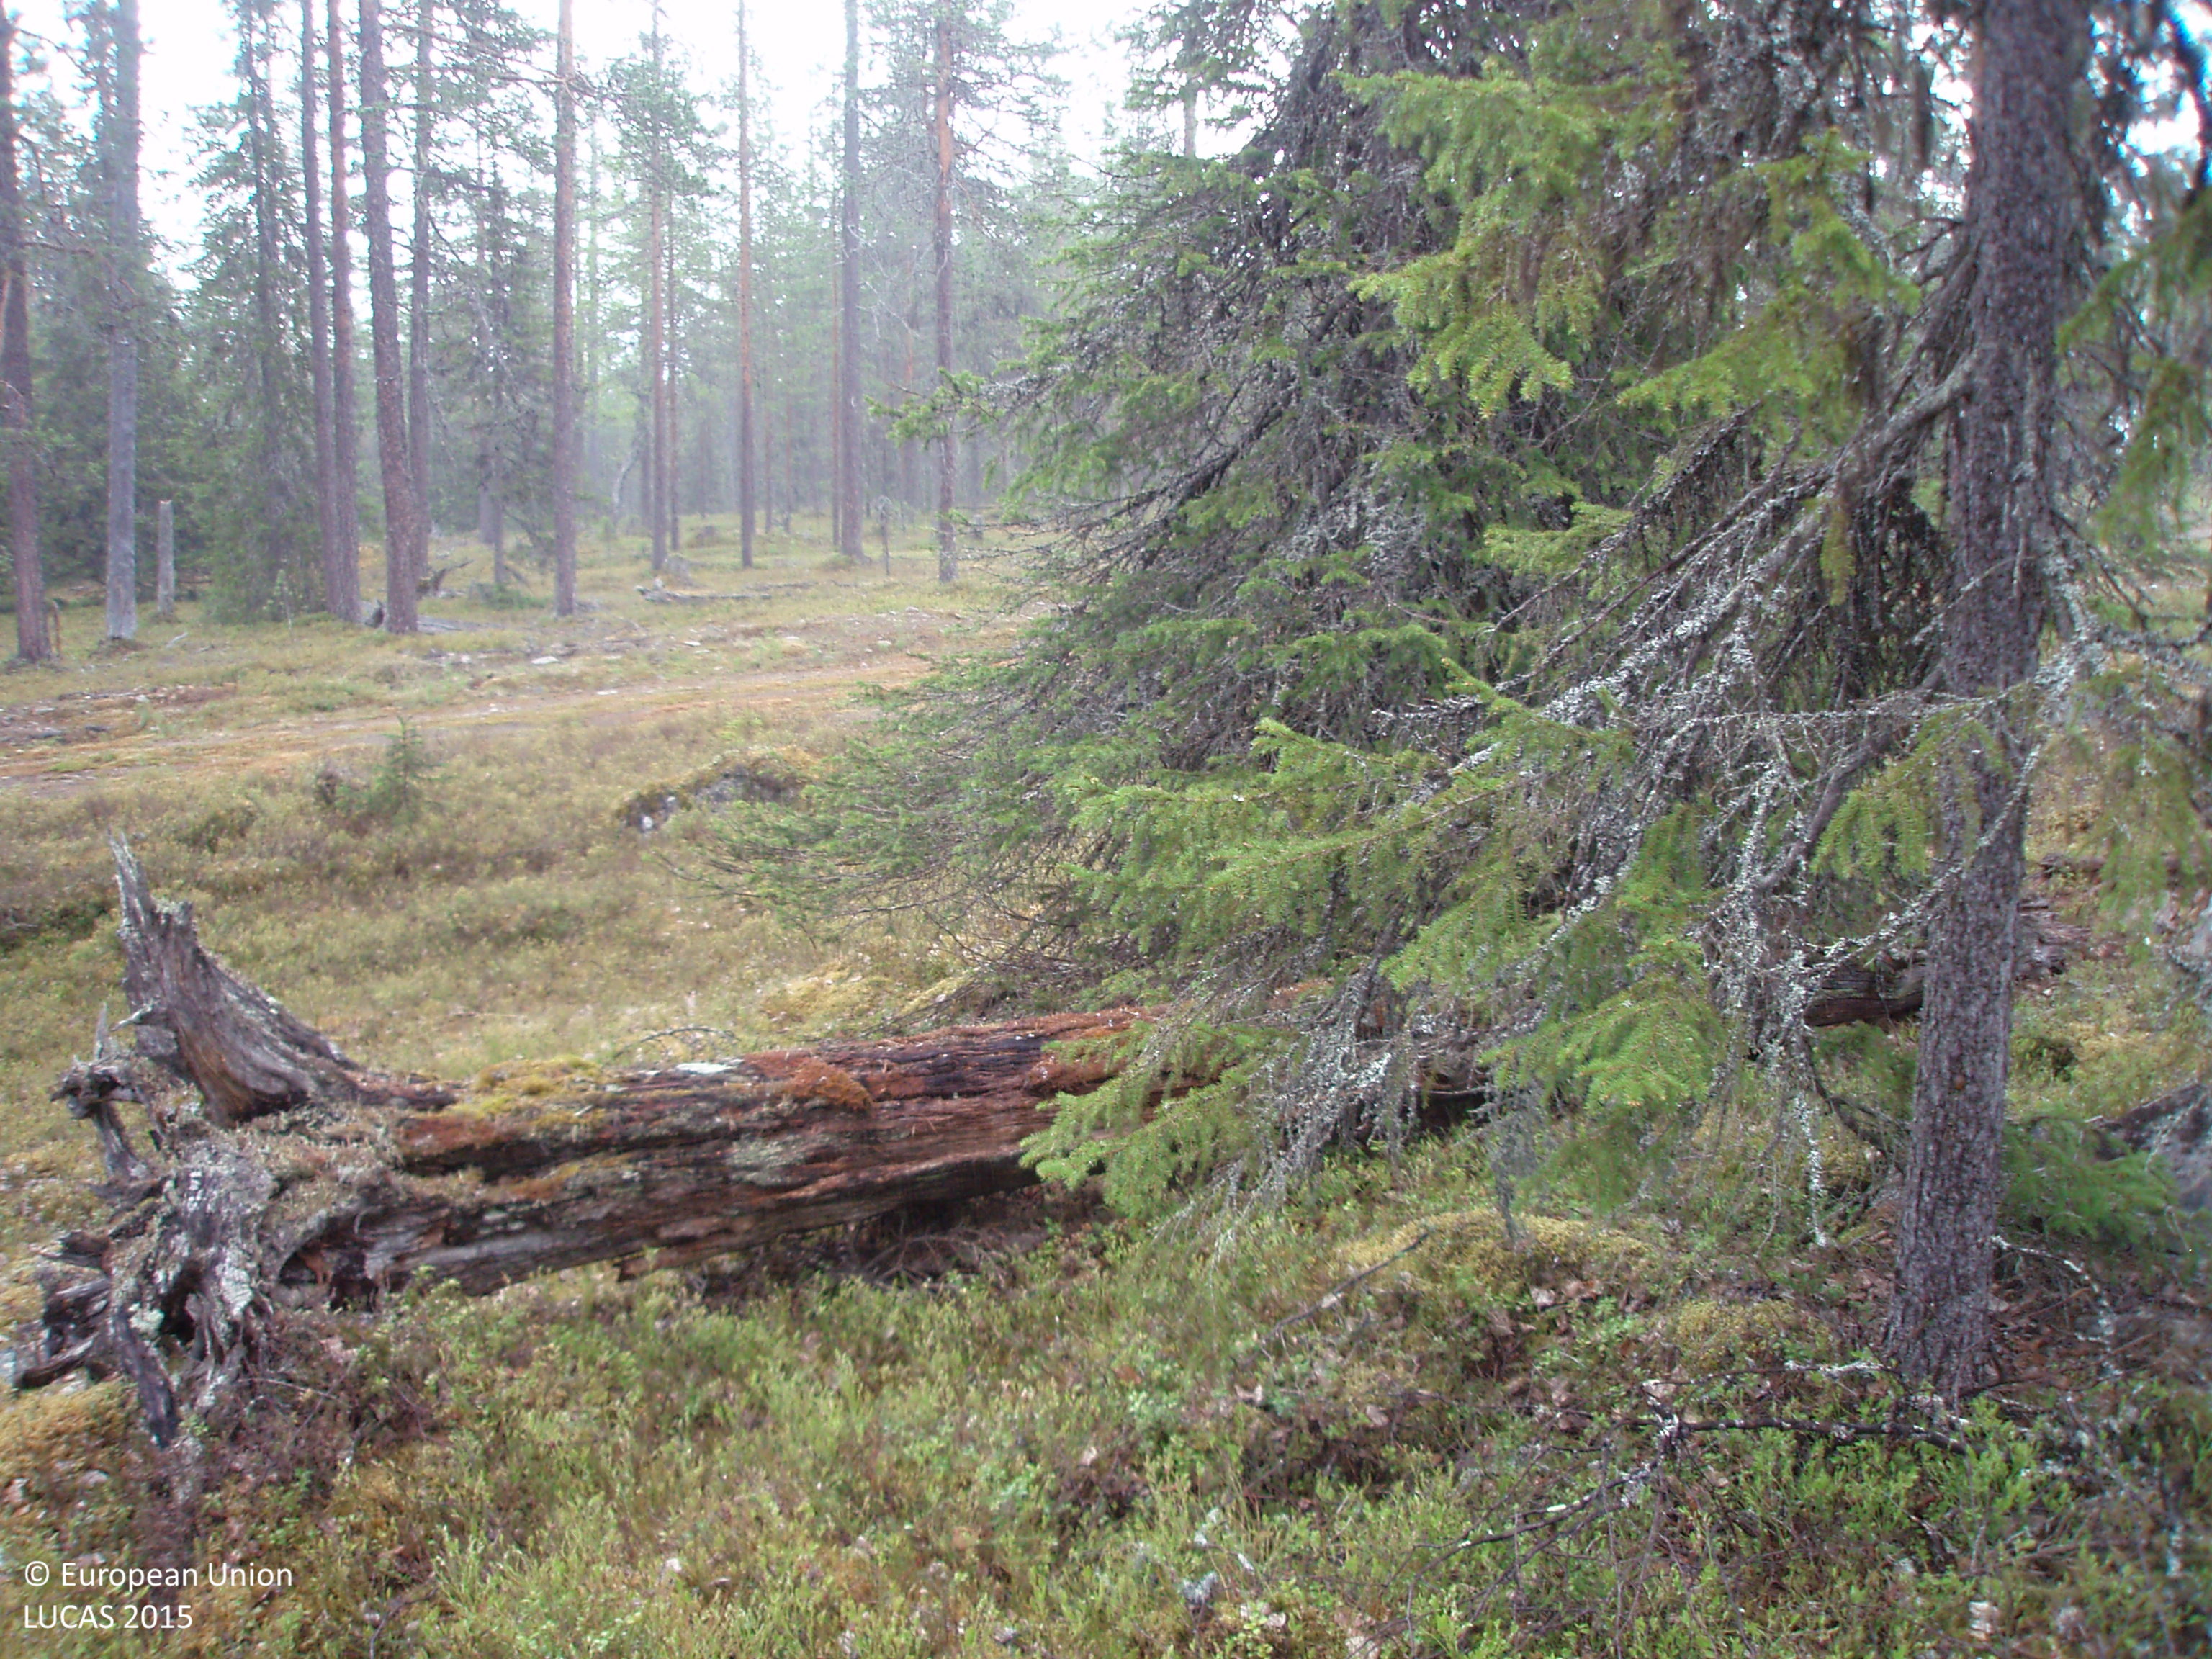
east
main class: Woodland
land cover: Other mixed woodland
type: boreal forest
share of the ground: 50 - 75 %
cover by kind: coniferous forest trees 40 %, shrubs 30 %, broadleaved forest trees 15 %, lichens and mosses 15 %
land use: Forestry
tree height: > 5 m
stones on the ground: < 10 %
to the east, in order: Other mixed woodland; Tracks; Other coniferous woodland; Tracks; Other coniferous woodland
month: June
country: FI
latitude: 67.1197
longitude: 26.9840
